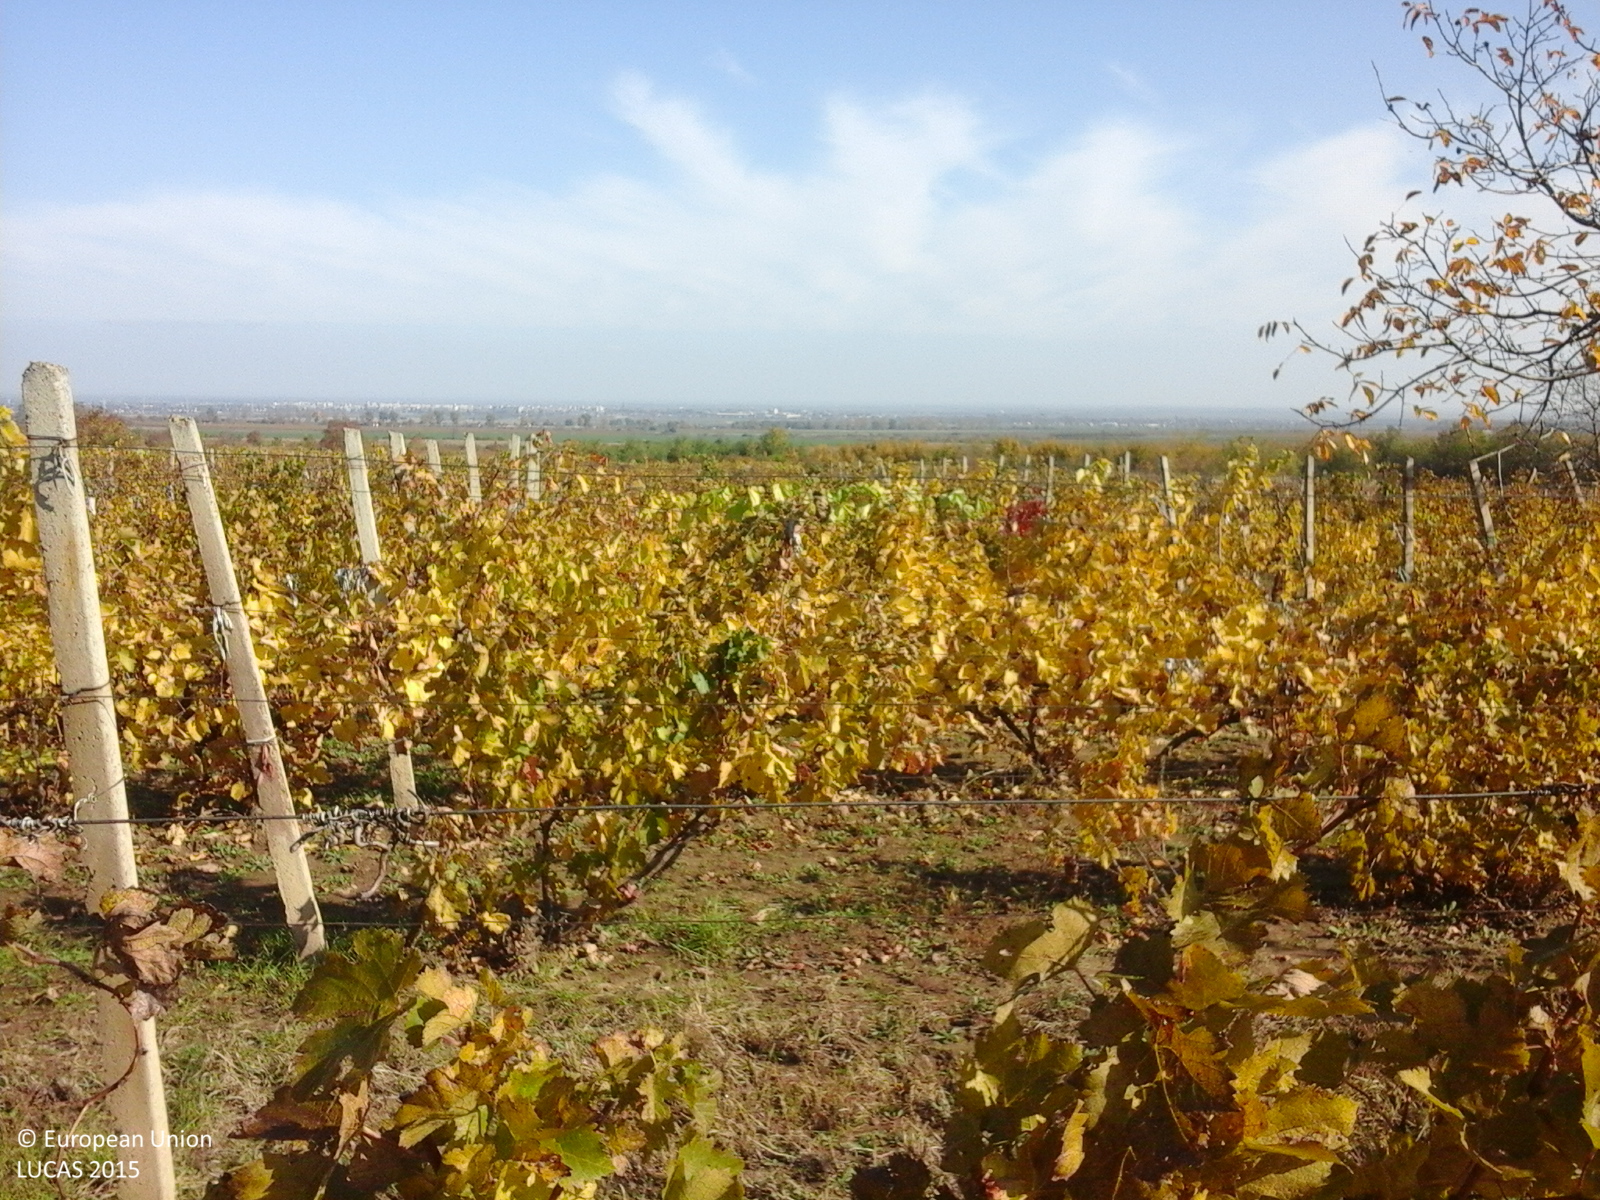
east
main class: Cropland
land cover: Vineyards
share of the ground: > 75 %
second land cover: Grassland without tree/shrub cover
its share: > 75 %
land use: Agriculture (excluding fallow land and kitchen gardens)
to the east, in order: Vineyards; Grassland without tree/shrub cover; Tracks; Vineyards; Grass margins; Tracks; Grass margins; Ditches and canals; Grass margins; Vineyards; Spontaneously vegetated surfaces; Vineyards
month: October
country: RO
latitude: 45.6646
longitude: 27.0722
